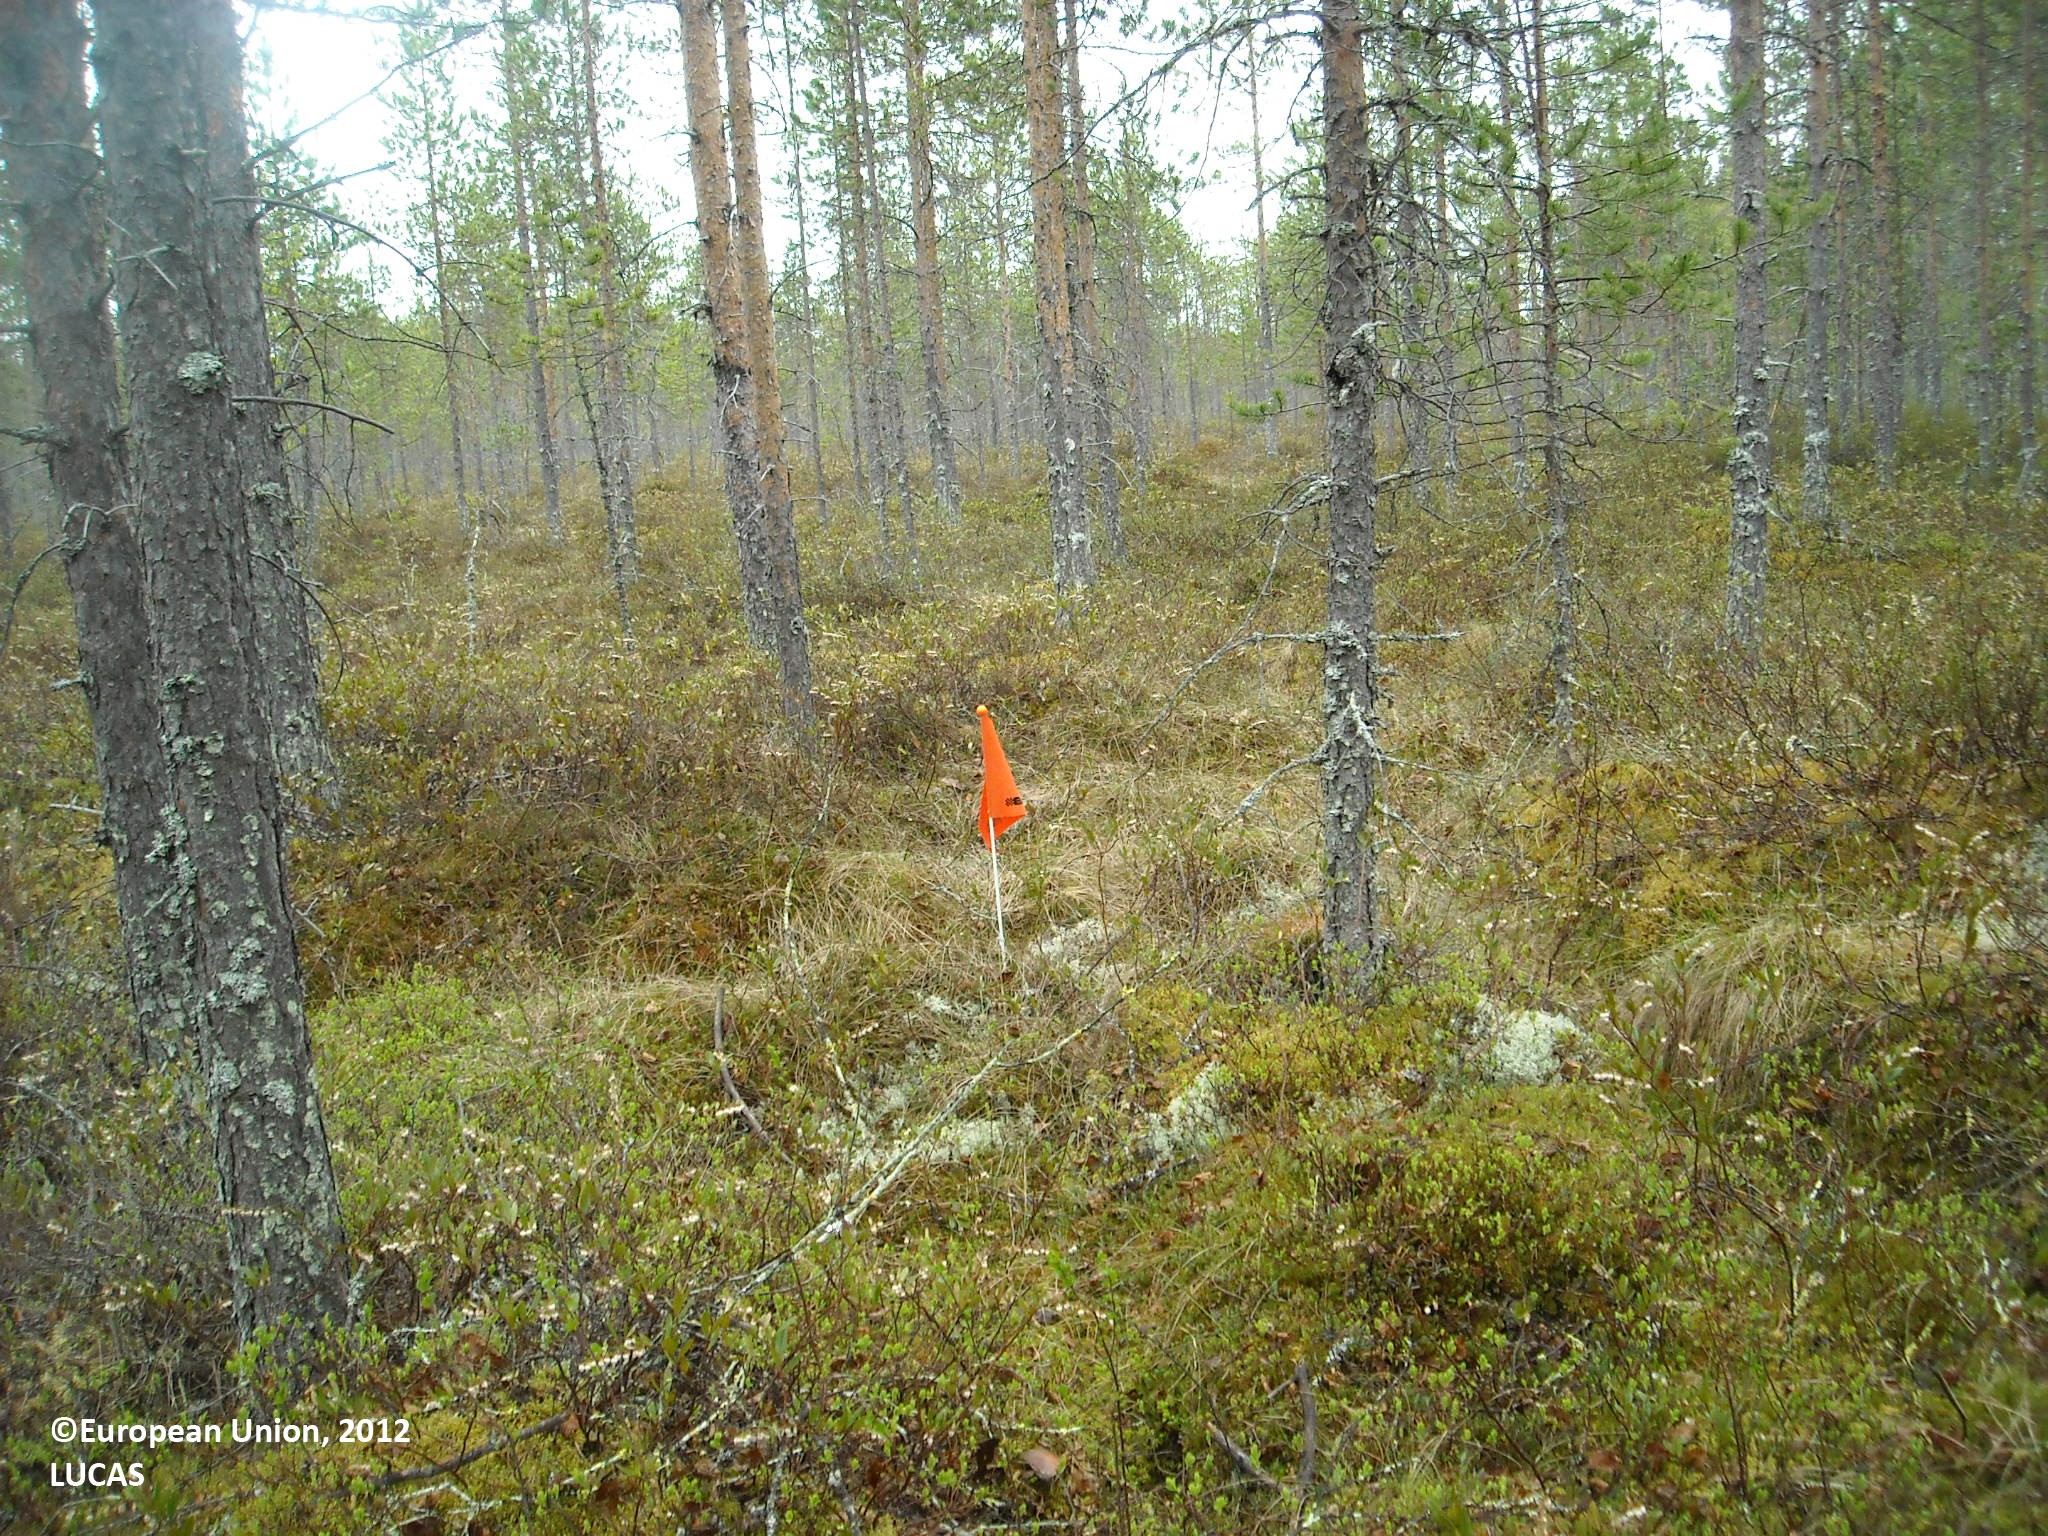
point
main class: Woodland
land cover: Pine dominated coniferous woodland
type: mire and swamp forests
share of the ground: > 75 %
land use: Forestry
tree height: > 5 m
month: June
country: FI
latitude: 64.5999
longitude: 27.2039
